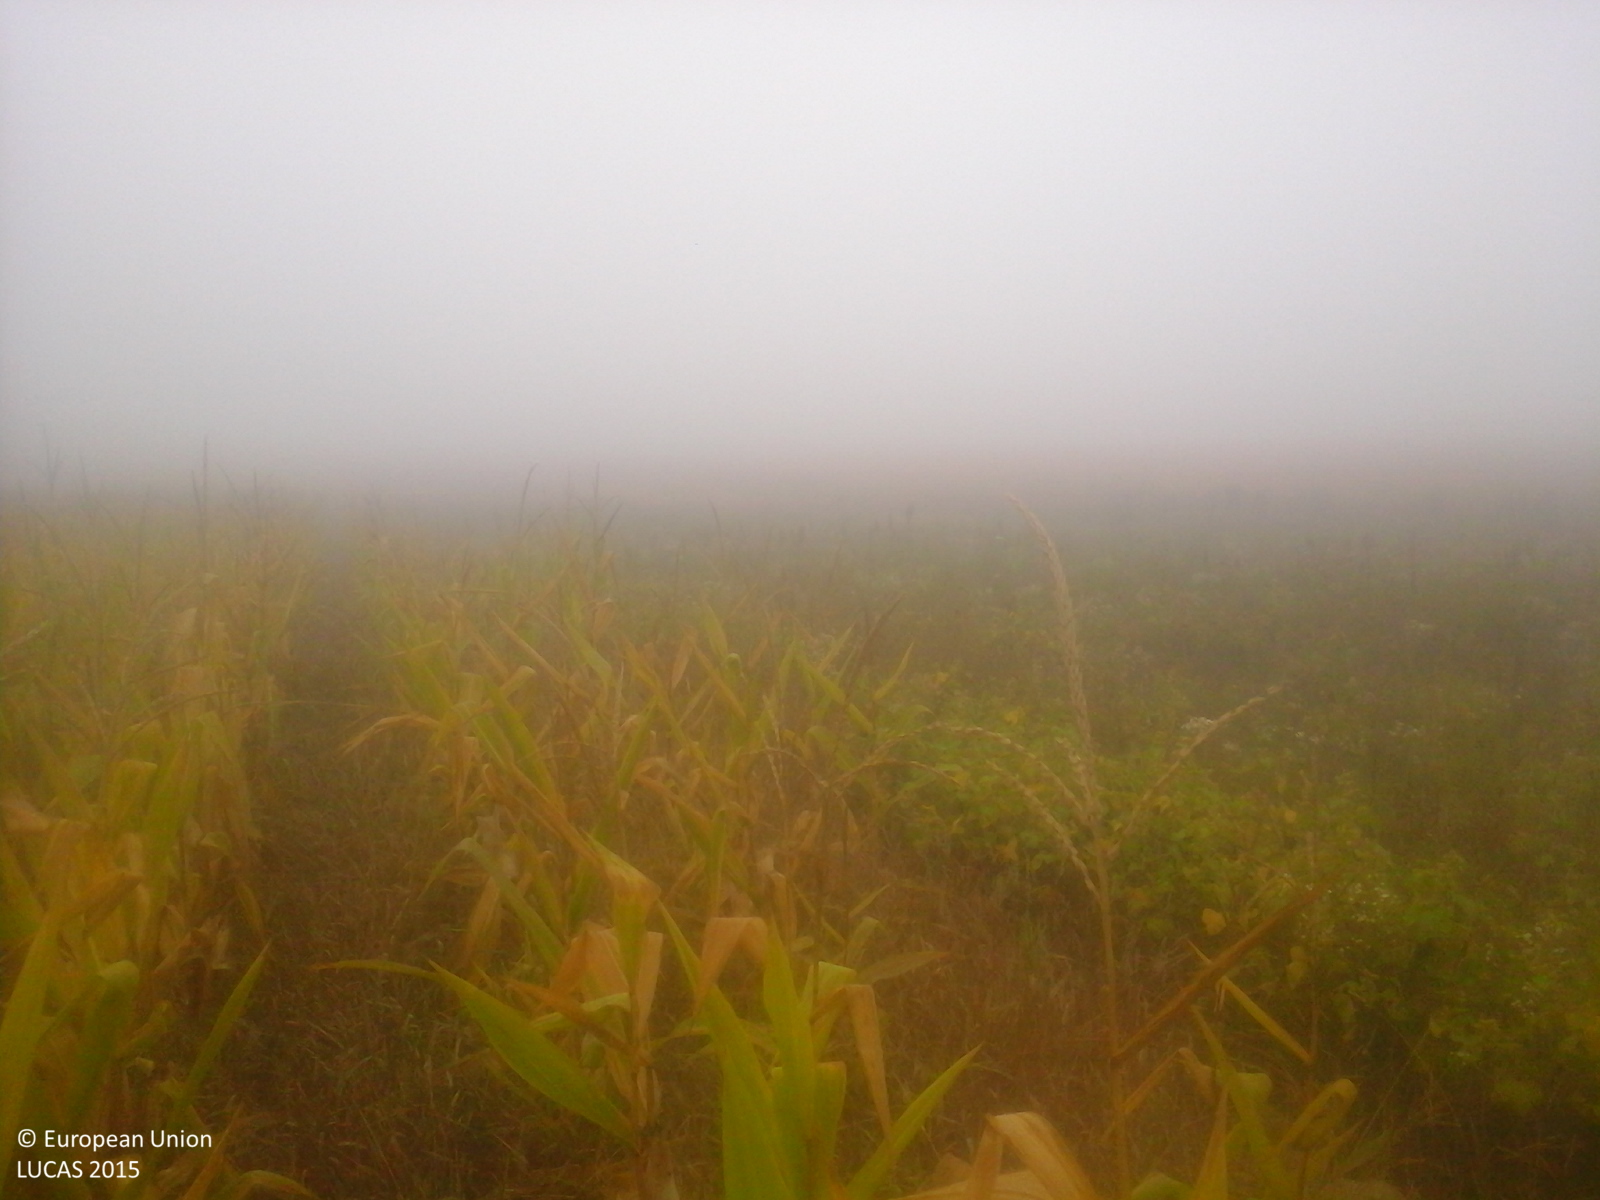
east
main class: Cropland
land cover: Maize
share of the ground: > 75 %
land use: Agriculture (excluding fallow land and kitchen gardens)
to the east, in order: Maize; Spontaneously vegetated surfaces; Tracks; Shruby margins; Maize
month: September
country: RO
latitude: 45.5852
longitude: 21.9713
